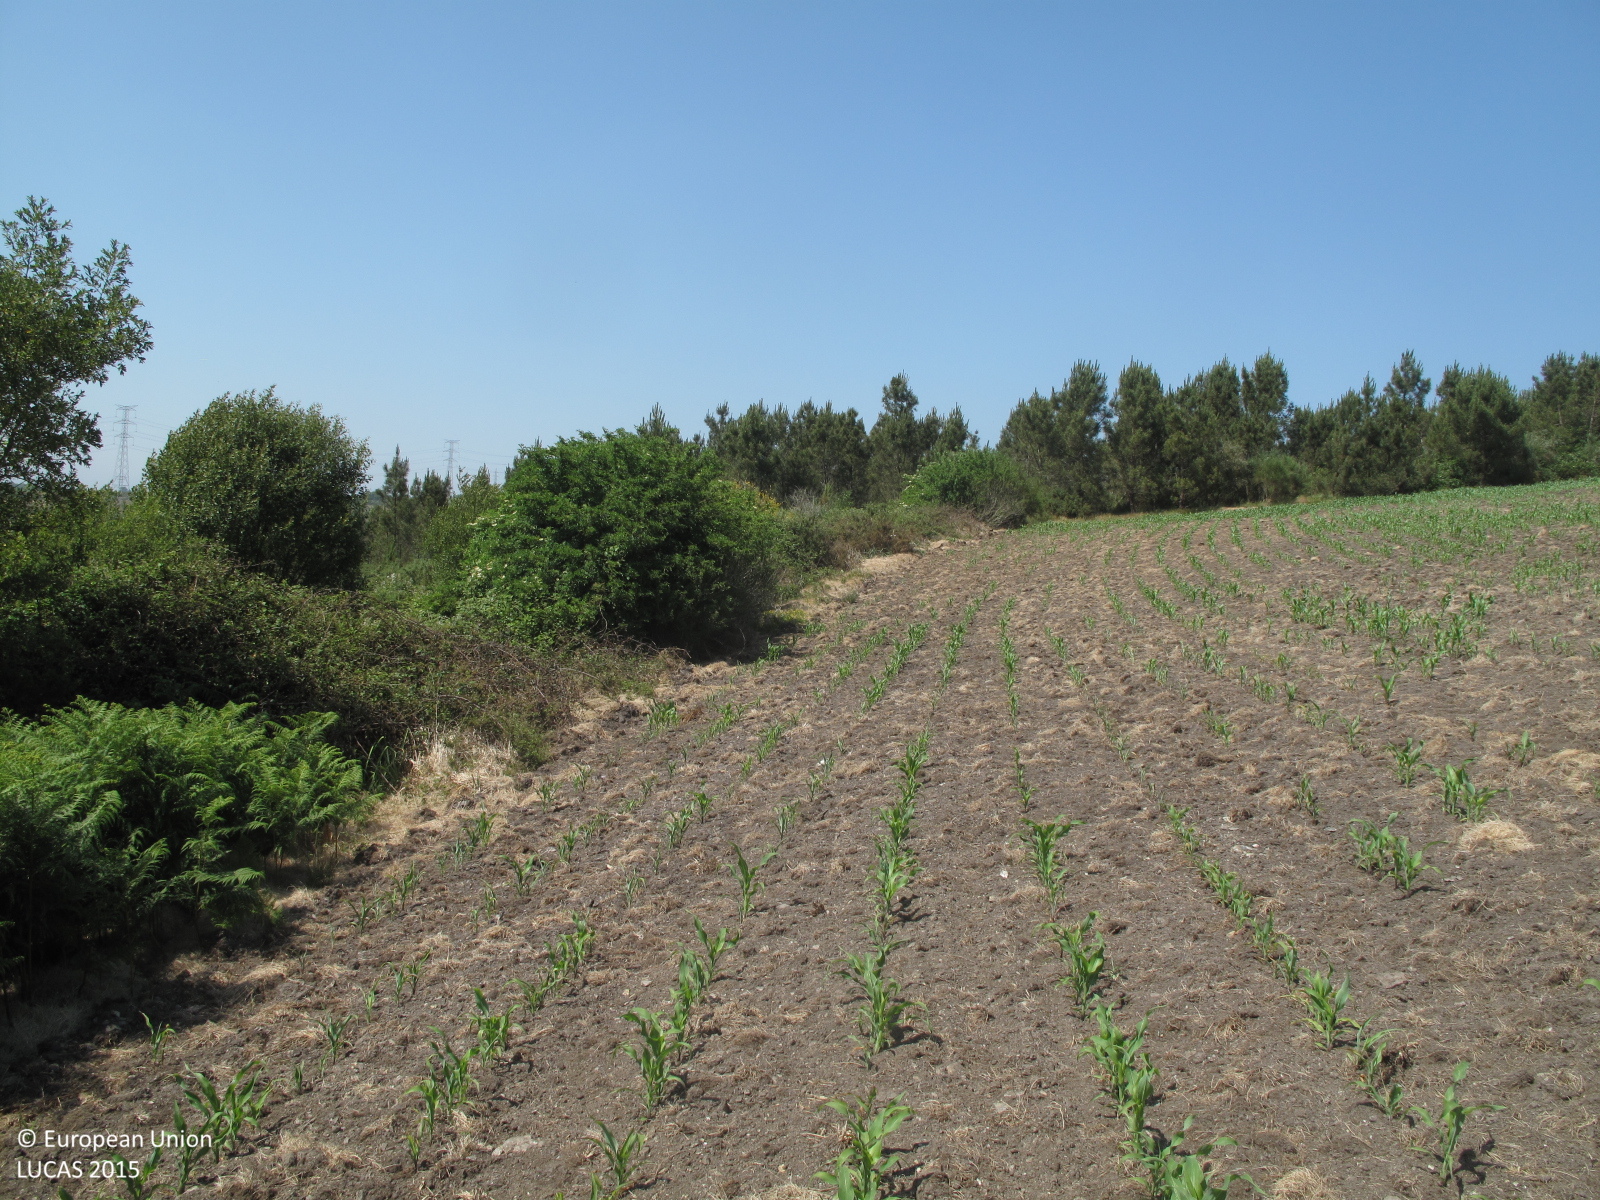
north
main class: Shrubland
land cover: Shrubland without tree cover
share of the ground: 50 - 75 %
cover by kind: shrubs 70 %, herbaceous plants 30 %
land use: Abandoned areas
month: June
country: ES
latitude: 43.2685
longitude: -7.9440
